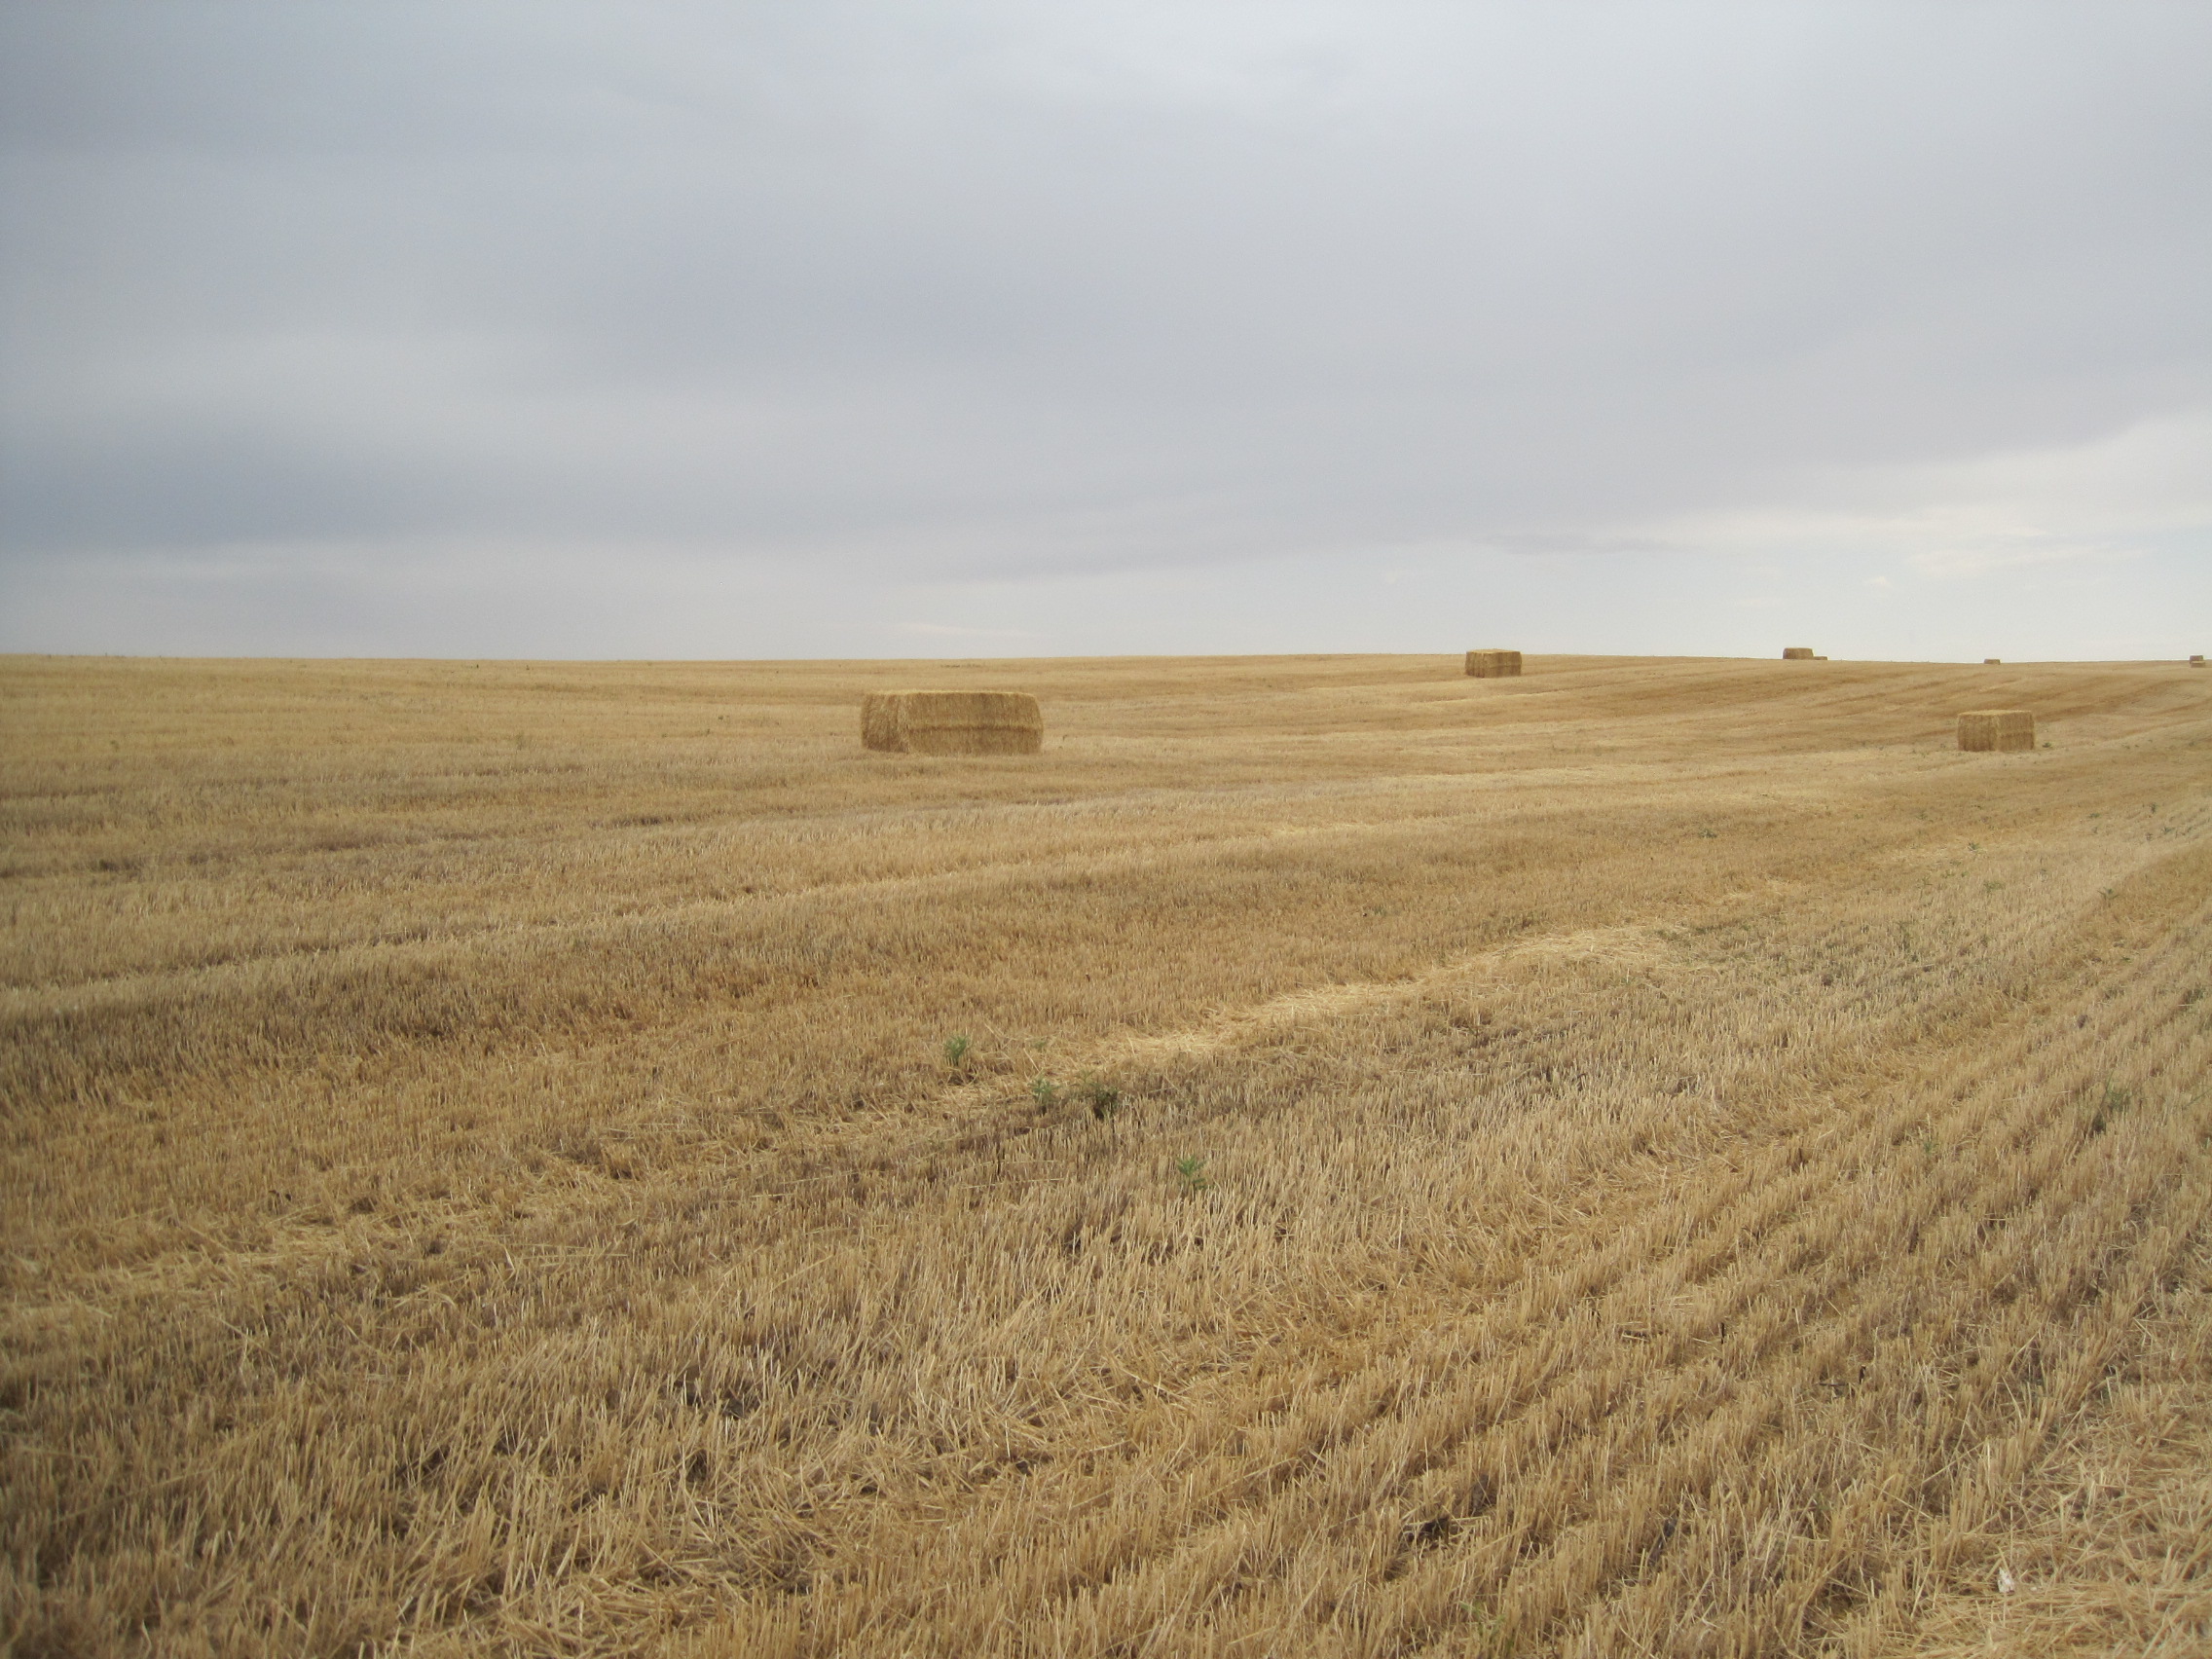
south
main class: Cropland
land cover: Barley
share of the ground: < 10 %
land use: Agriculture (excluding fallow land and kitchen gardens)
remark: Harvested field
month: July
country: ES
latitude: 41.7934
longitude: -5.5500
